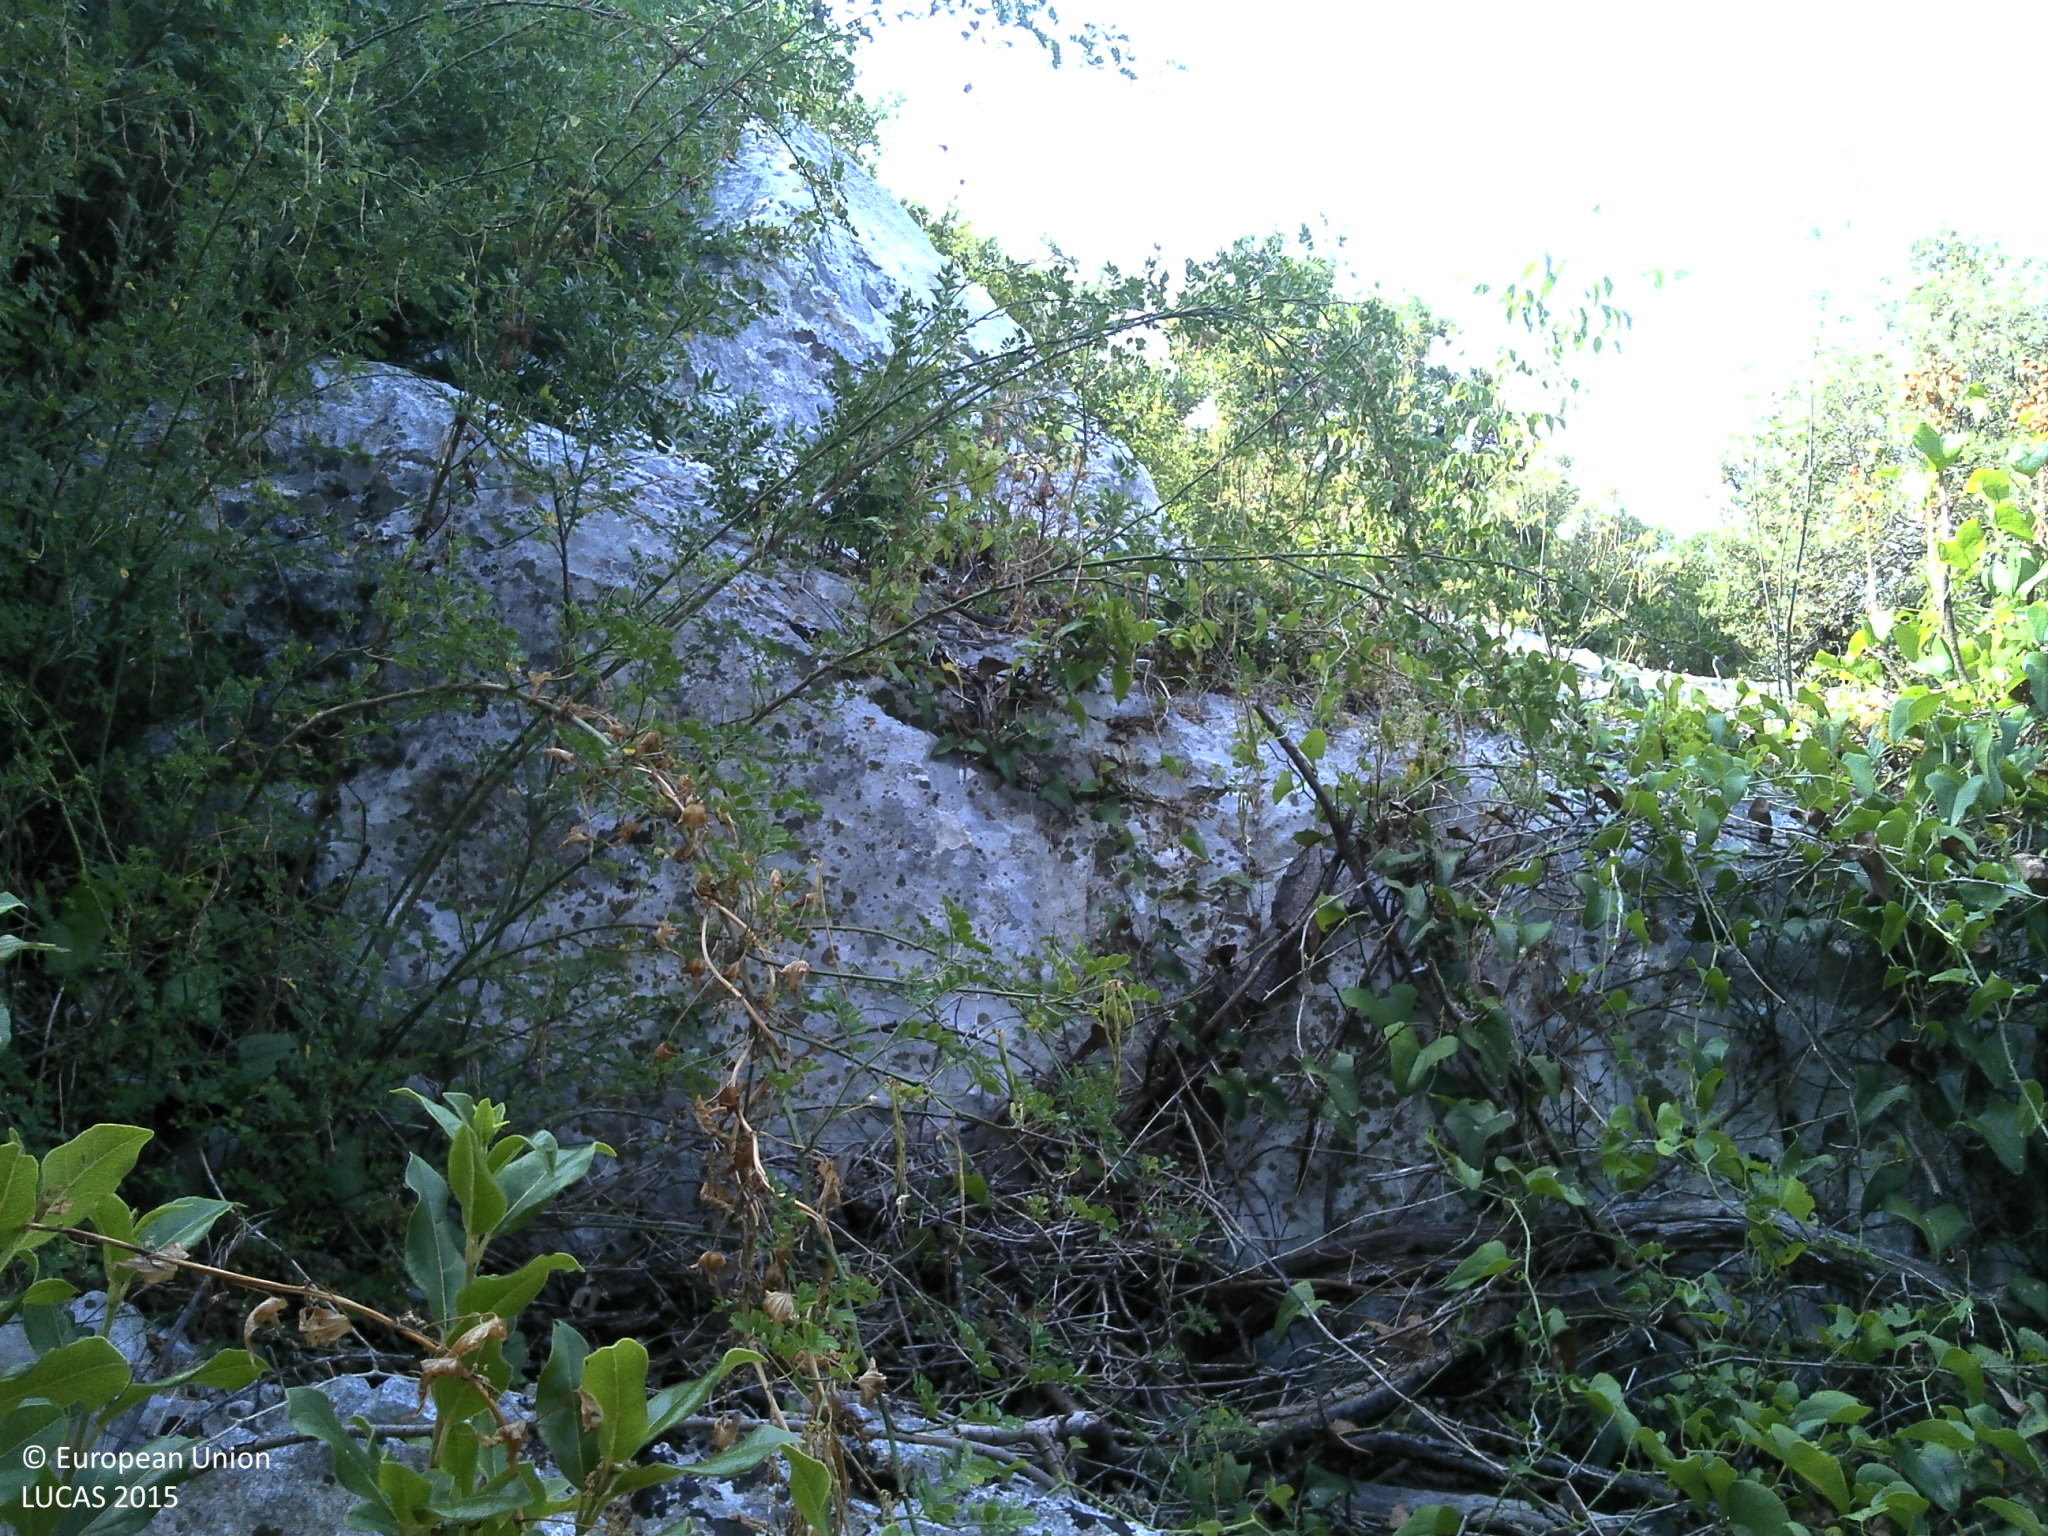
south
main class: Woodland
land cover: Broadleaved woodland
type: thermophilous deciduous forest
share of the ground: 25 - 50 %
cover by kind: broadleaved forest trees 40 %, shrubs 30 %, consolidated bare surface 20 %, unconsolidated bare surface 10 %
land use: Semi-natural and natural areas not in use
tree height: > 5 m
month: June
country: HR
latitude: 43.4952
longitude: 16.2108
